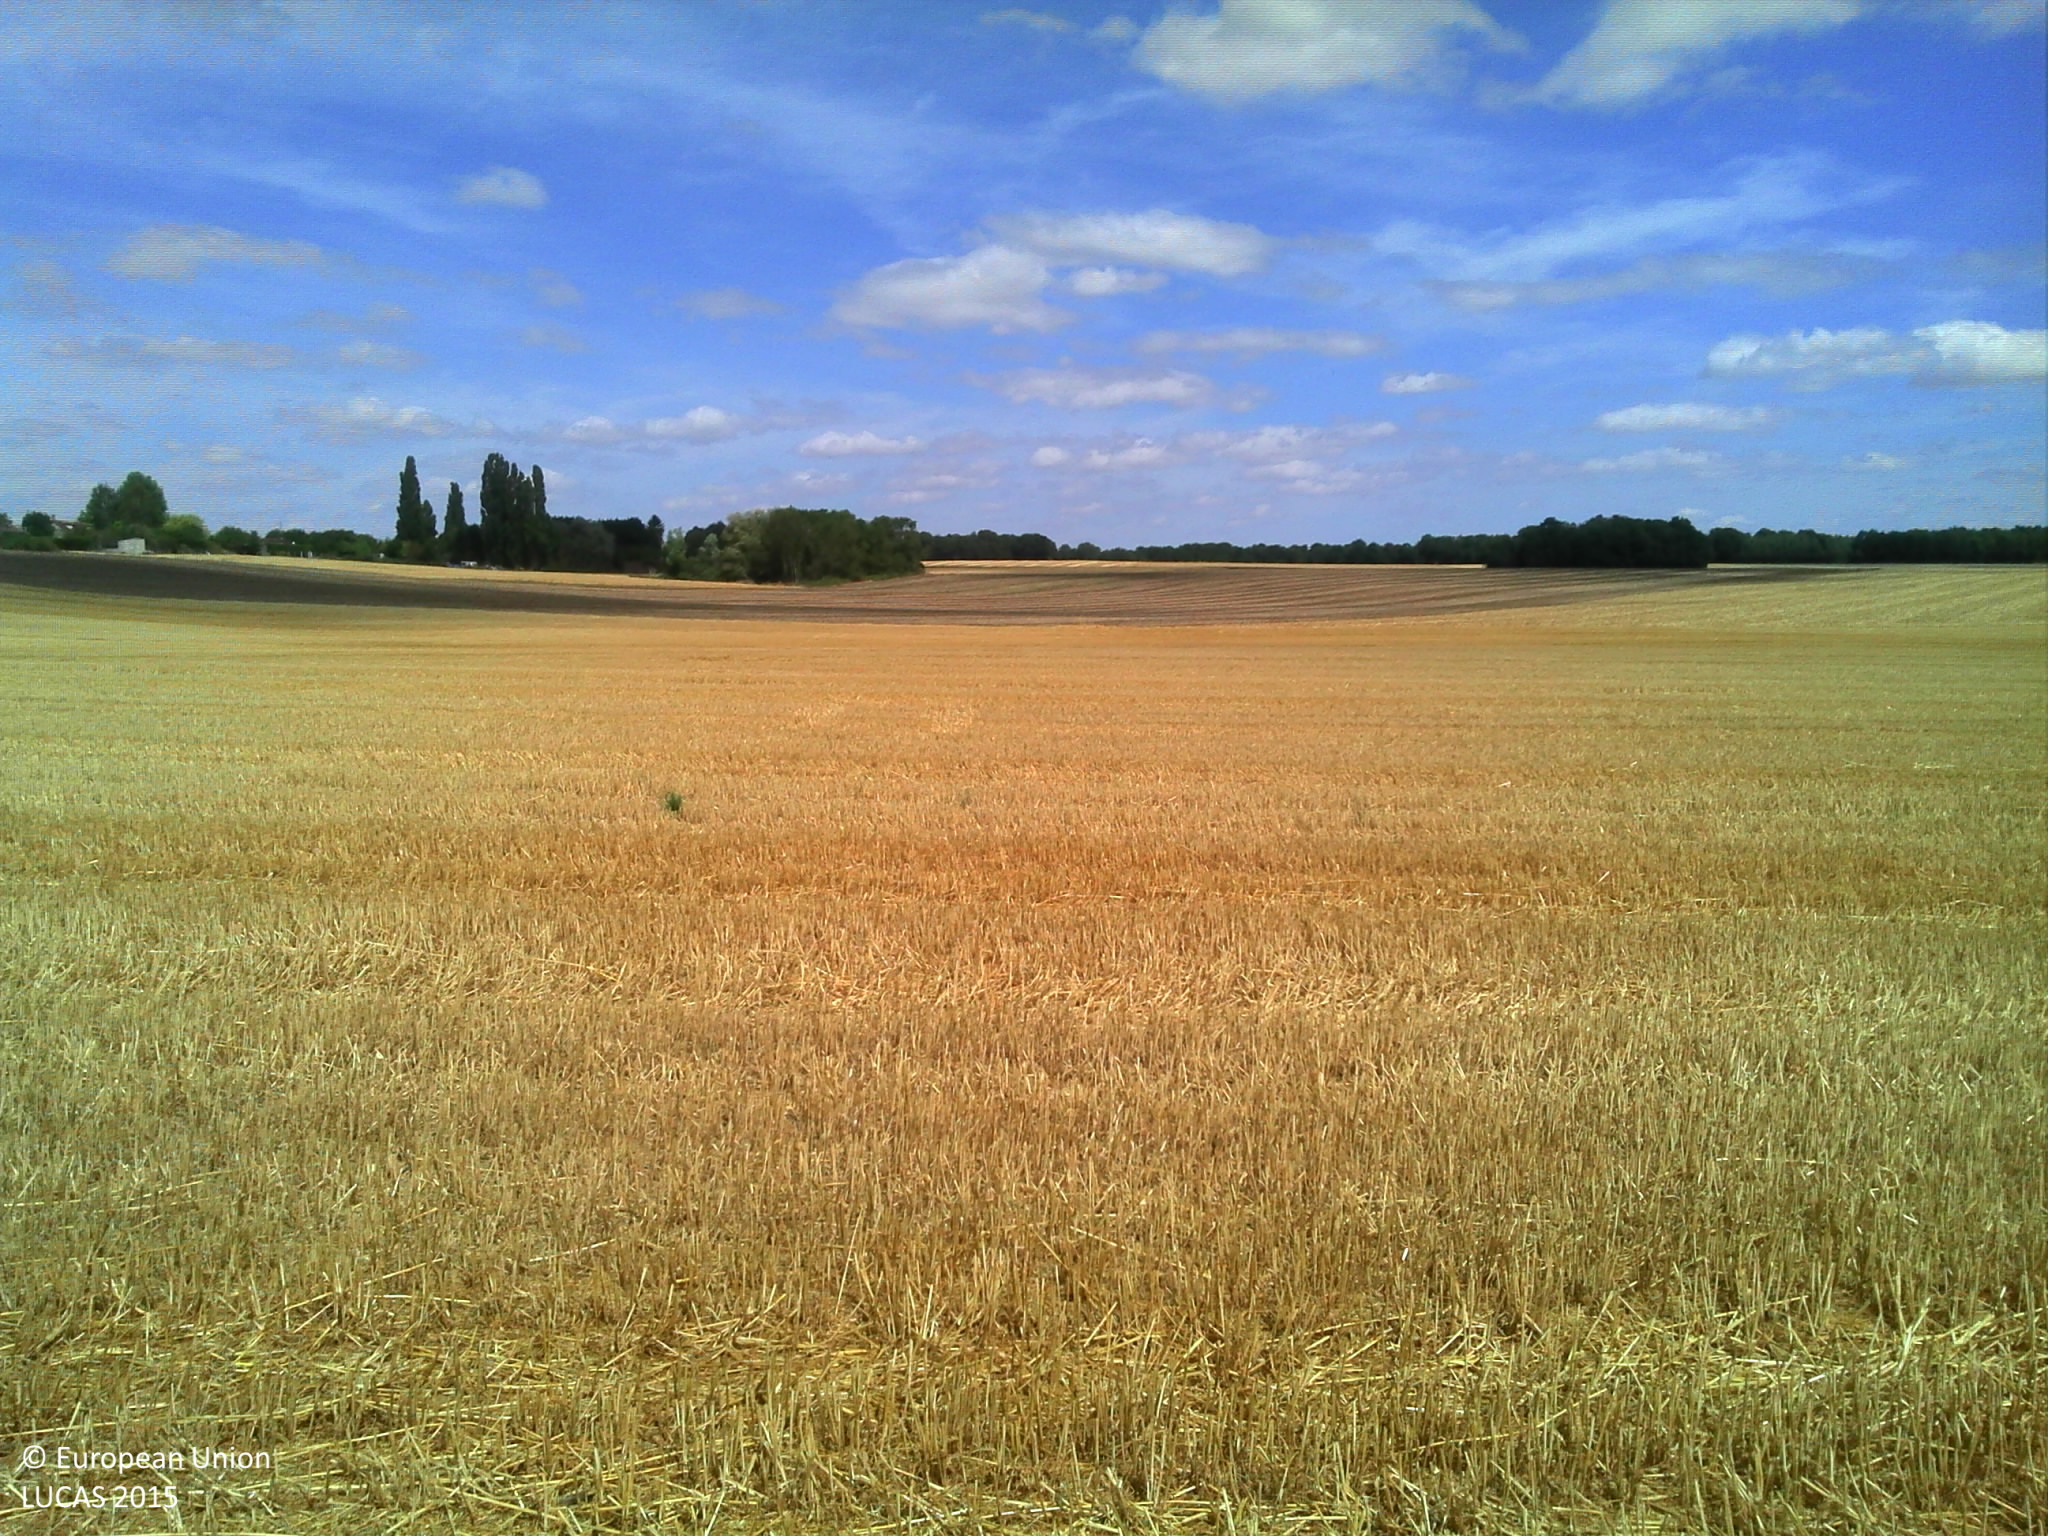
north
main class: Cropland
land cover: Durum wheat
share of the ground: 10 - 25 %
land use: Agriculture (excluding fallow land and kitchen gardens)
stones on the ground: 10 - 25 %
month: August
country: FR
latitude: 48.7134
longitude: 3.4290
